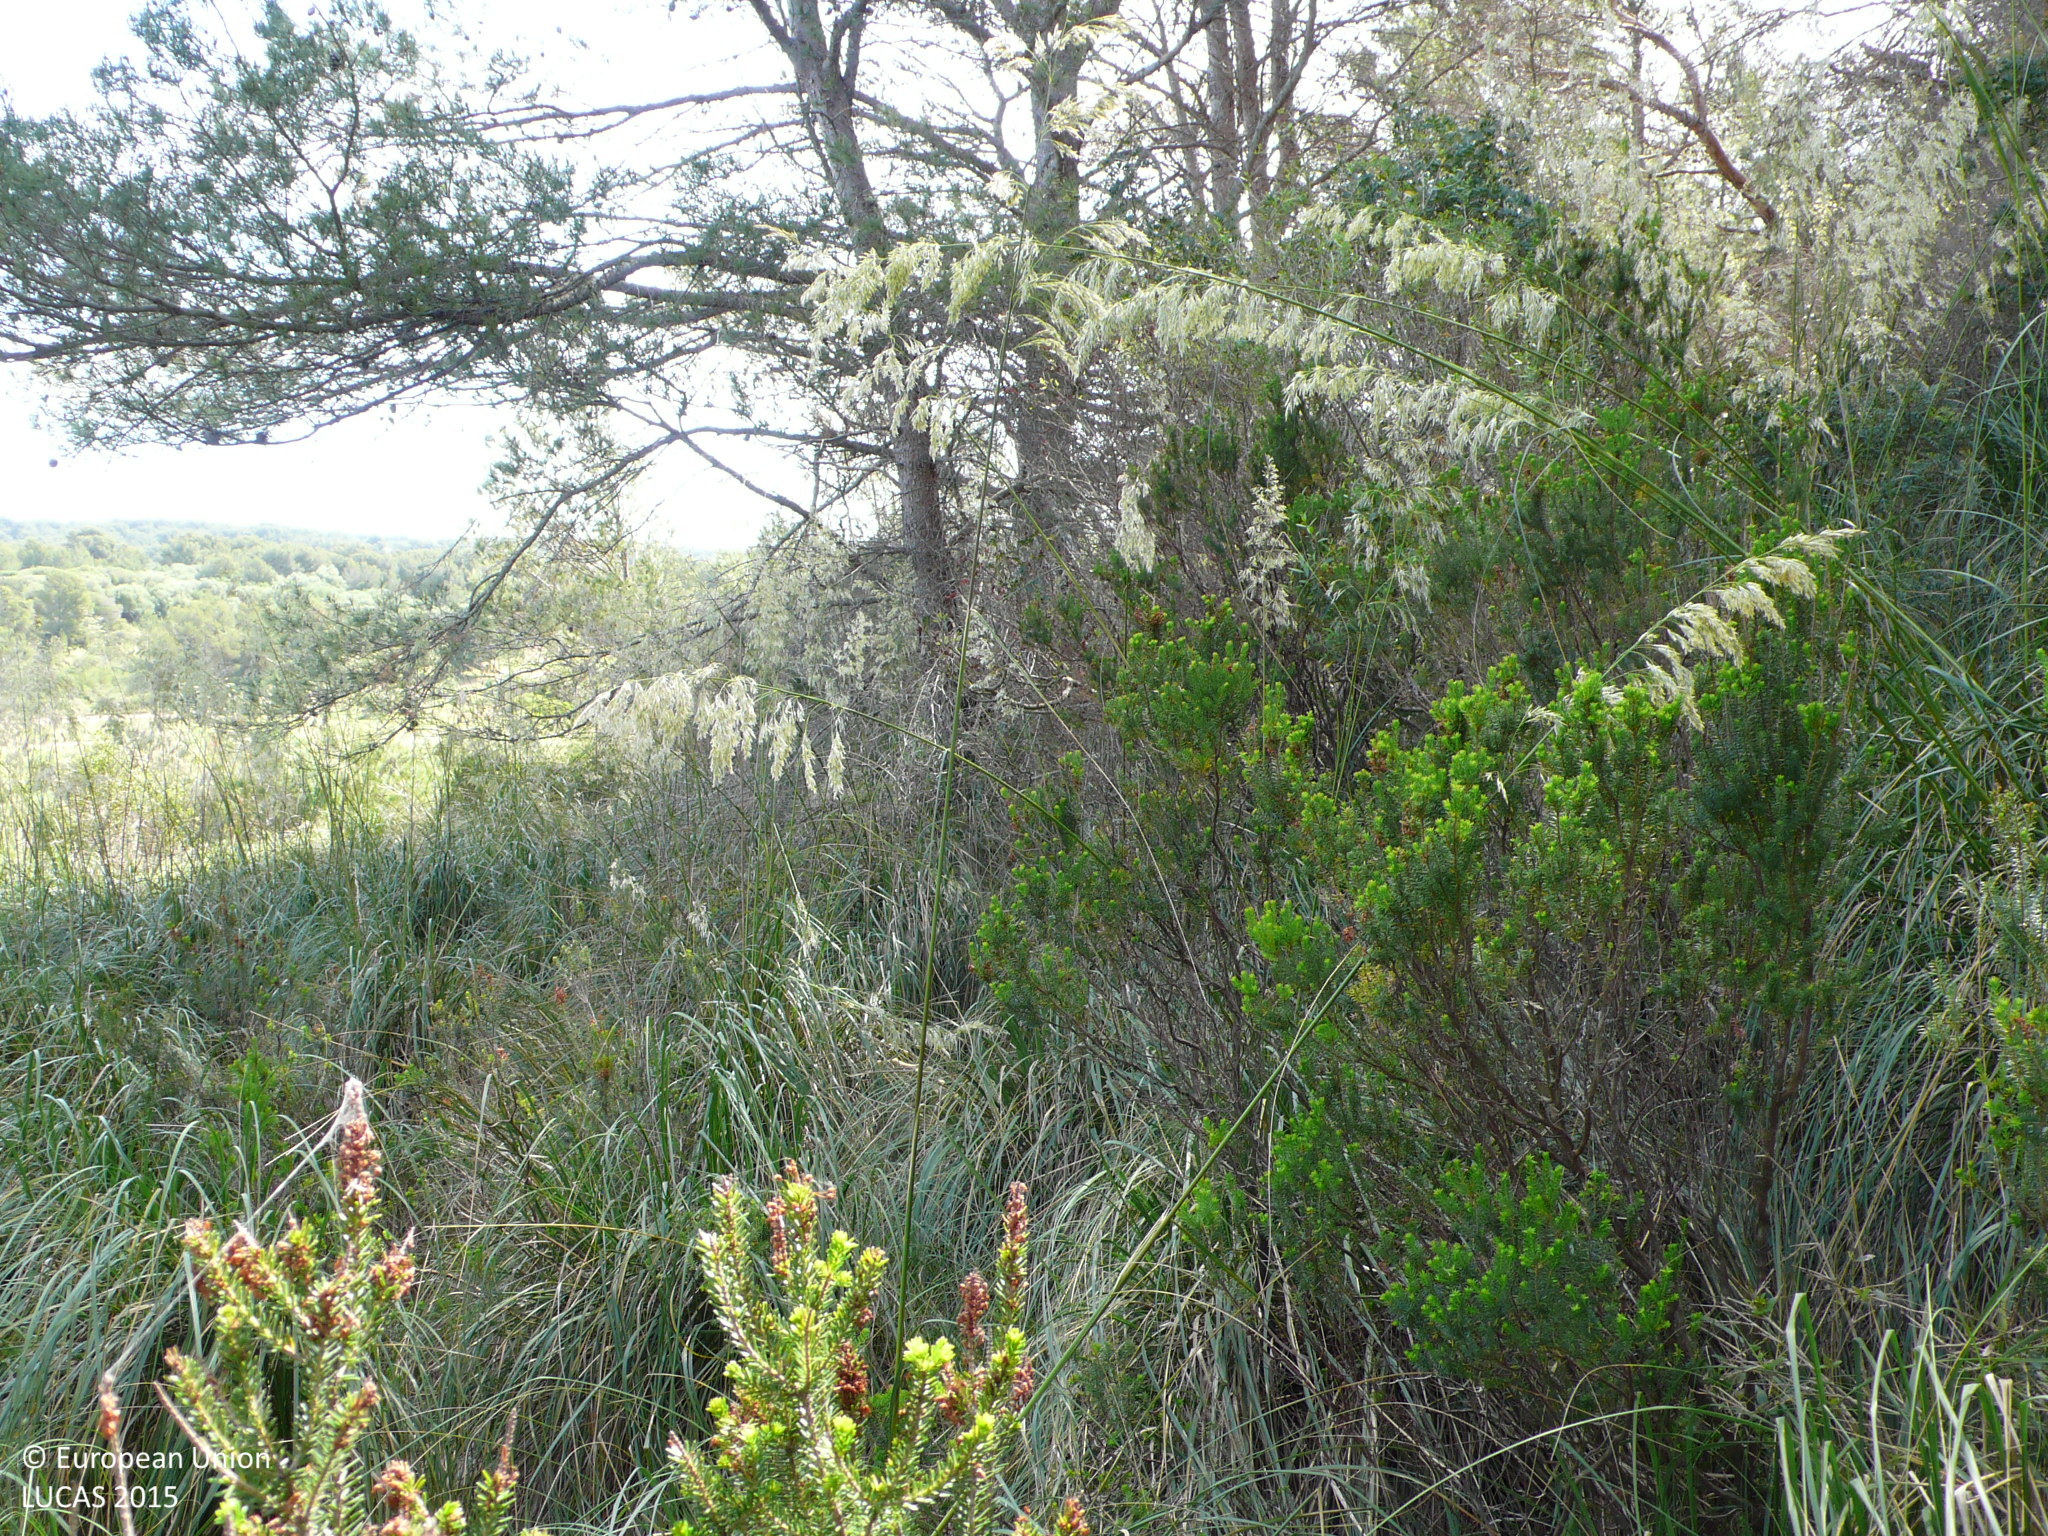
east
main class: Woodland
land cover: Pine dominated coniferous woodland
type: coniferous forest of the mediterranean region
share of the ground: > 75 %
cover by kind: coniferous forest trees 75 %, herbaceous plants 15 %, shrubs 10 %
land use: Semi-natural and natural areas not in use
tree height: > 5 m
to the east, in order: Pine dominated coniferous woodland; Grassland without tree/shrub cover; Broadleaved woodland; Pine dominated coniferous woodland; Grassland with sparse tree/shrub cover; Ditches and canals; Grassland without tree/shrub cover
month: May
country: ES
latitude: 40.0204
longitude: 4.1555
